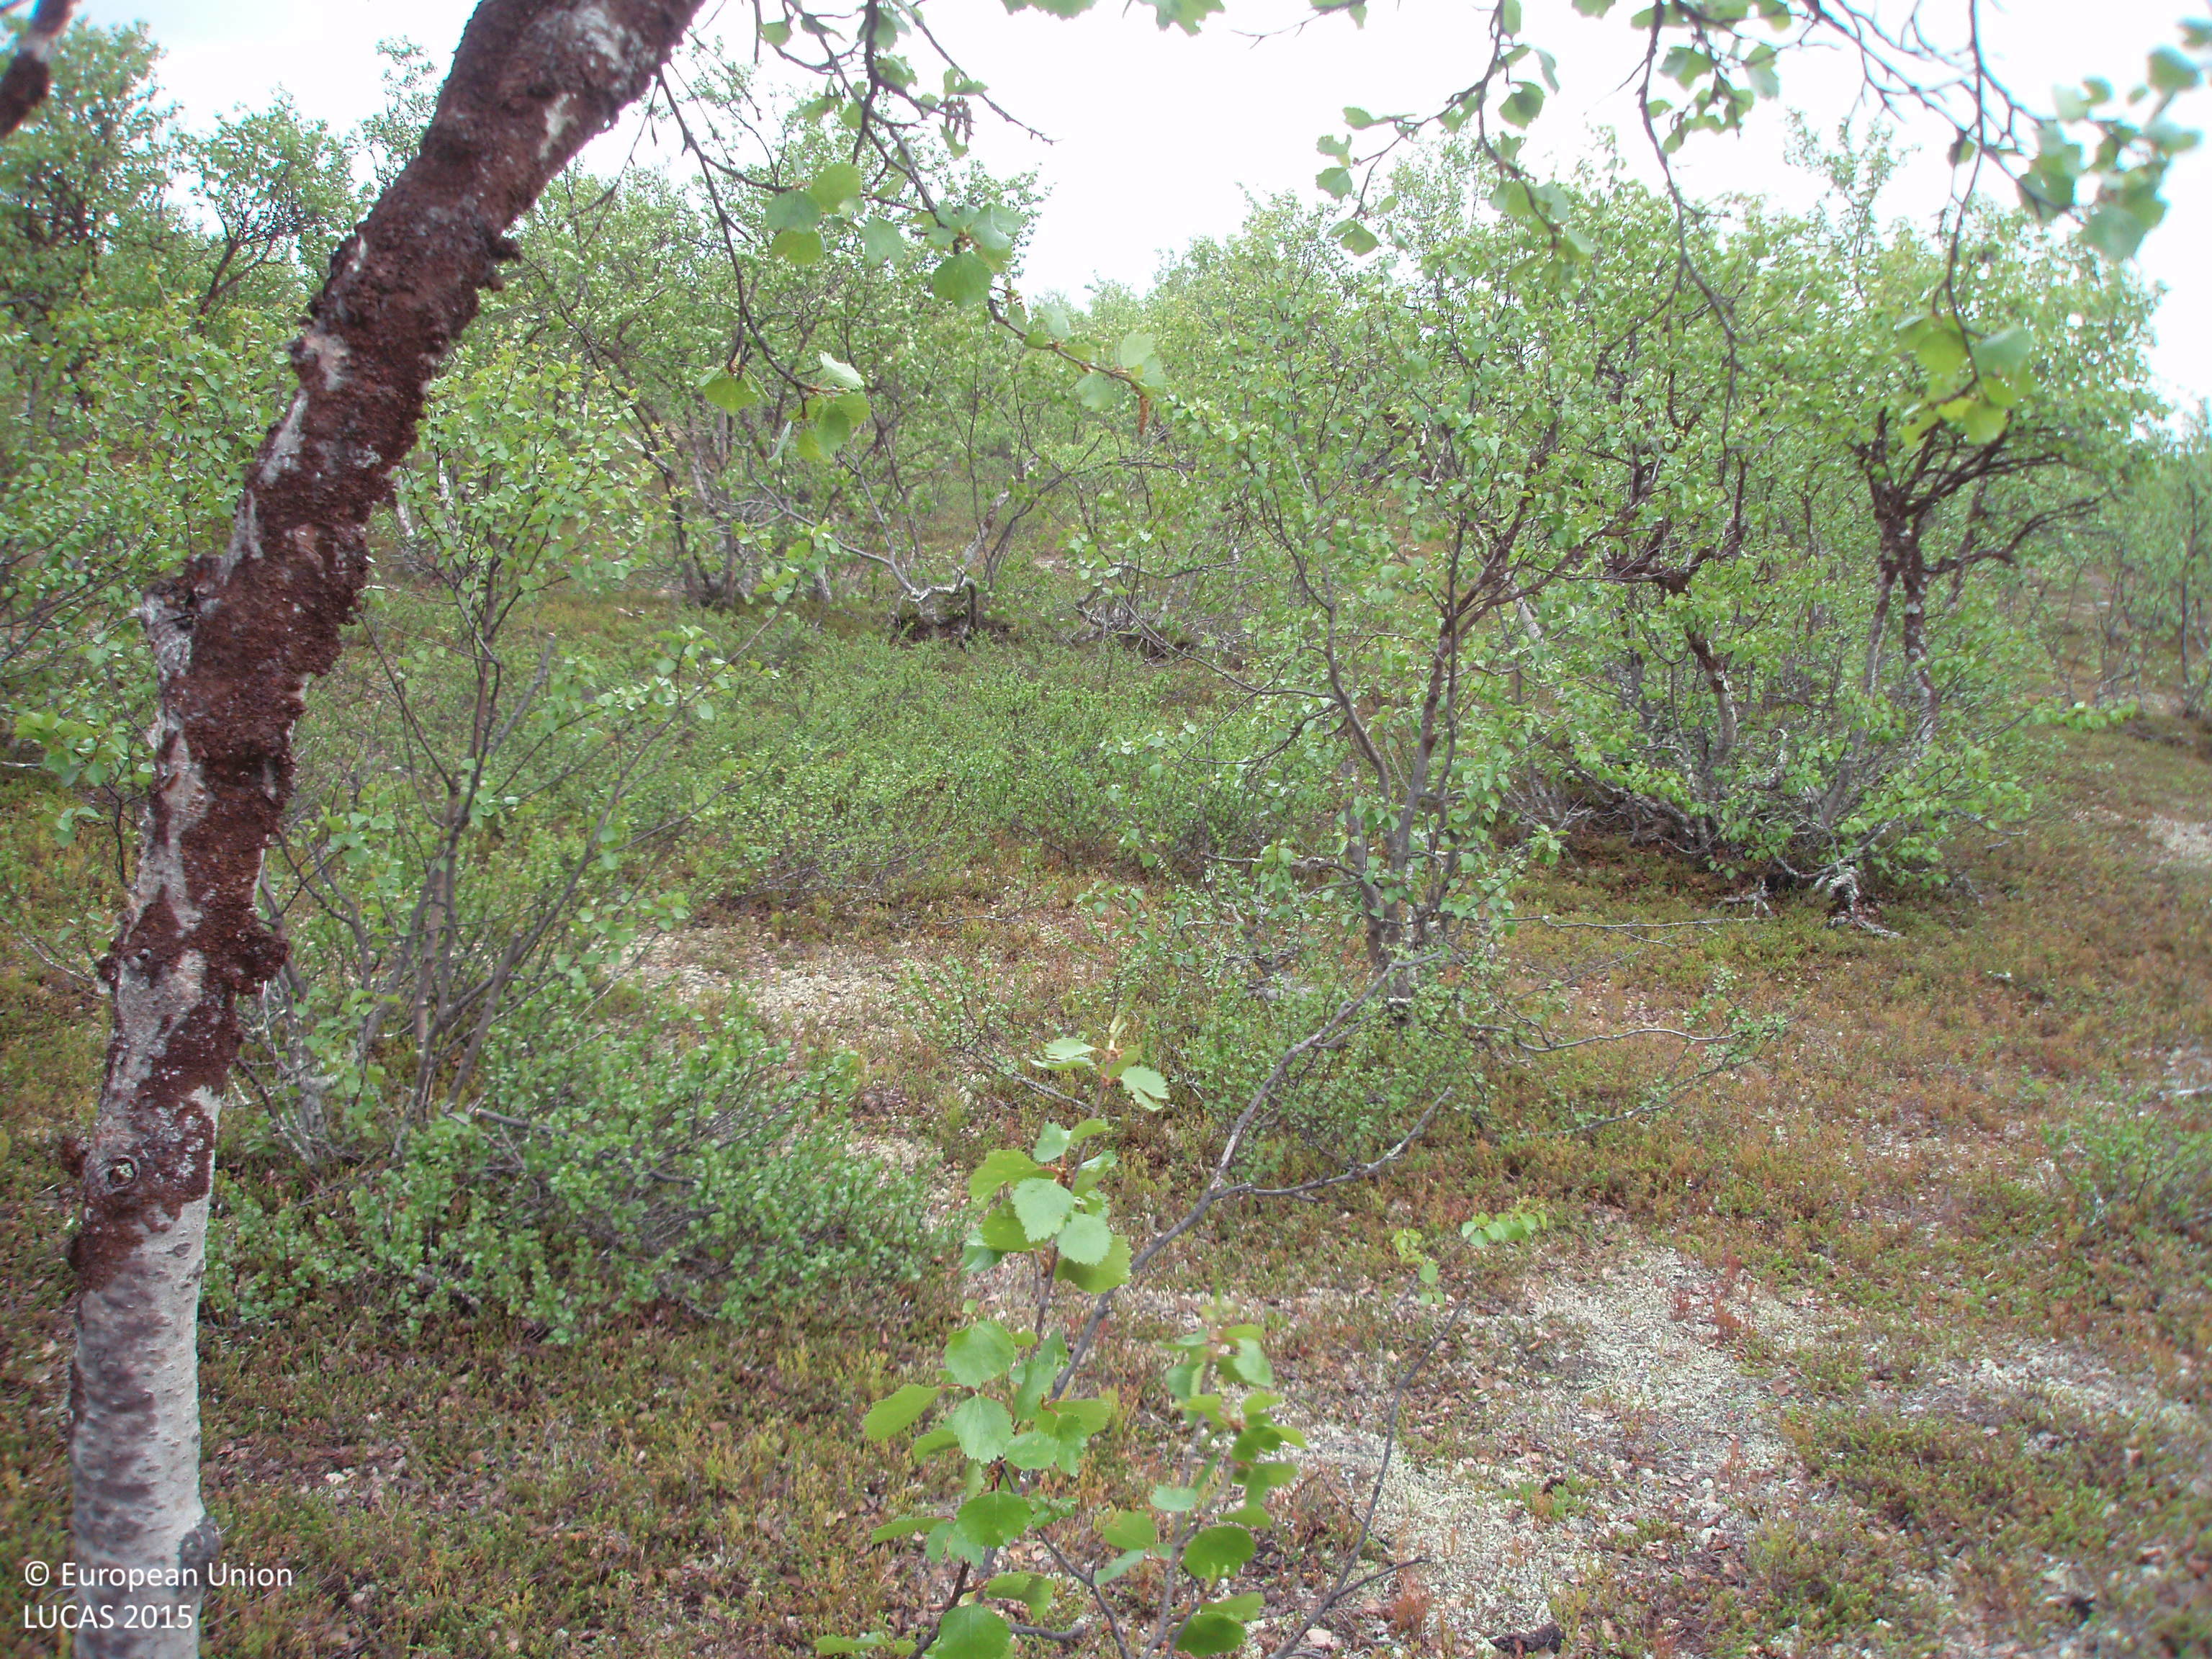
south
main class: Woodland
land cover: Broadleaved woodland
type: boreal forest
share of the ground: 50 - 75 %
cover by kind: broadleaved forest trees 60 %, shrubs 35 %, lichens and mosses 5 %
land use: Semi-natural and natural areas not in use
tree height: > 5 m
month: July
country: FI
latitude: 69.4700
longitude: 27.2504
